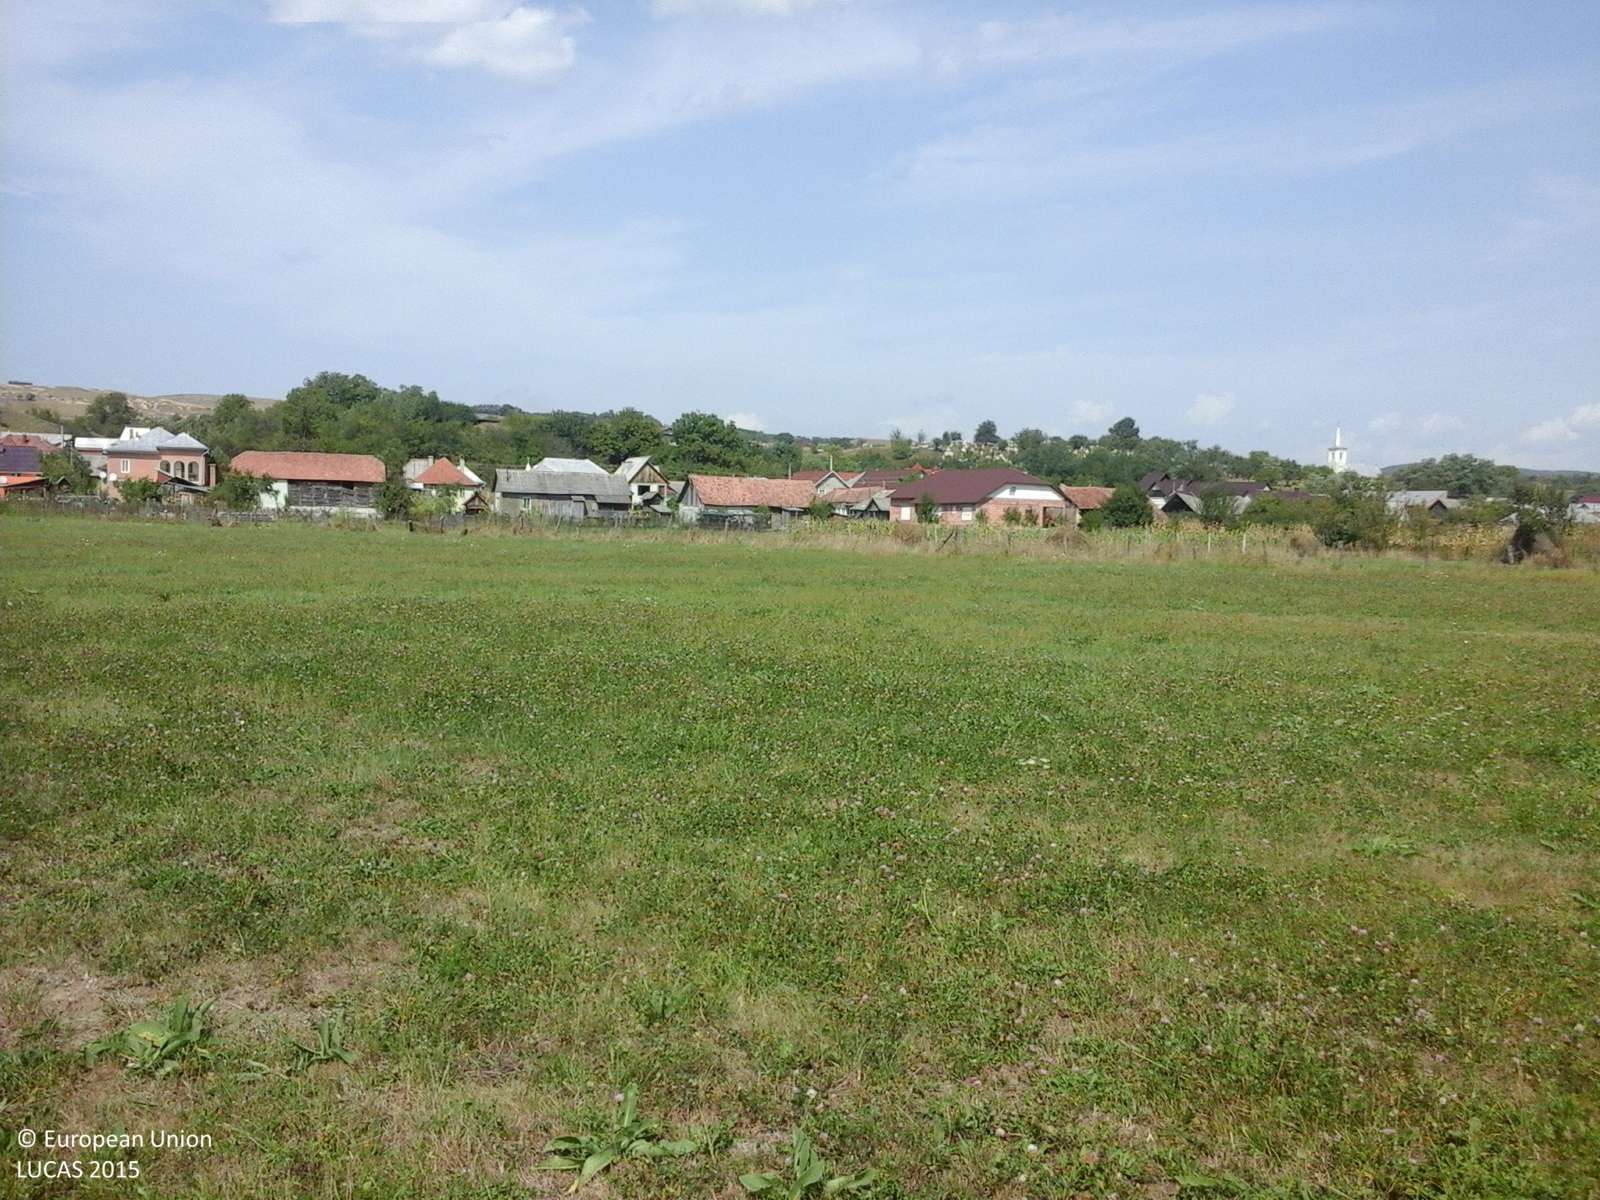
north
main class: Grassland
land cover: Grassland without tree/shrub cover
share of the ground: > 75 %
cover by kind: herbaceous plants 100 %
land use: Agriculture (excluding fallow land and kitchen gardens)
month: September
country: RO
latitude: 47.2317
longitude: 24.1514
